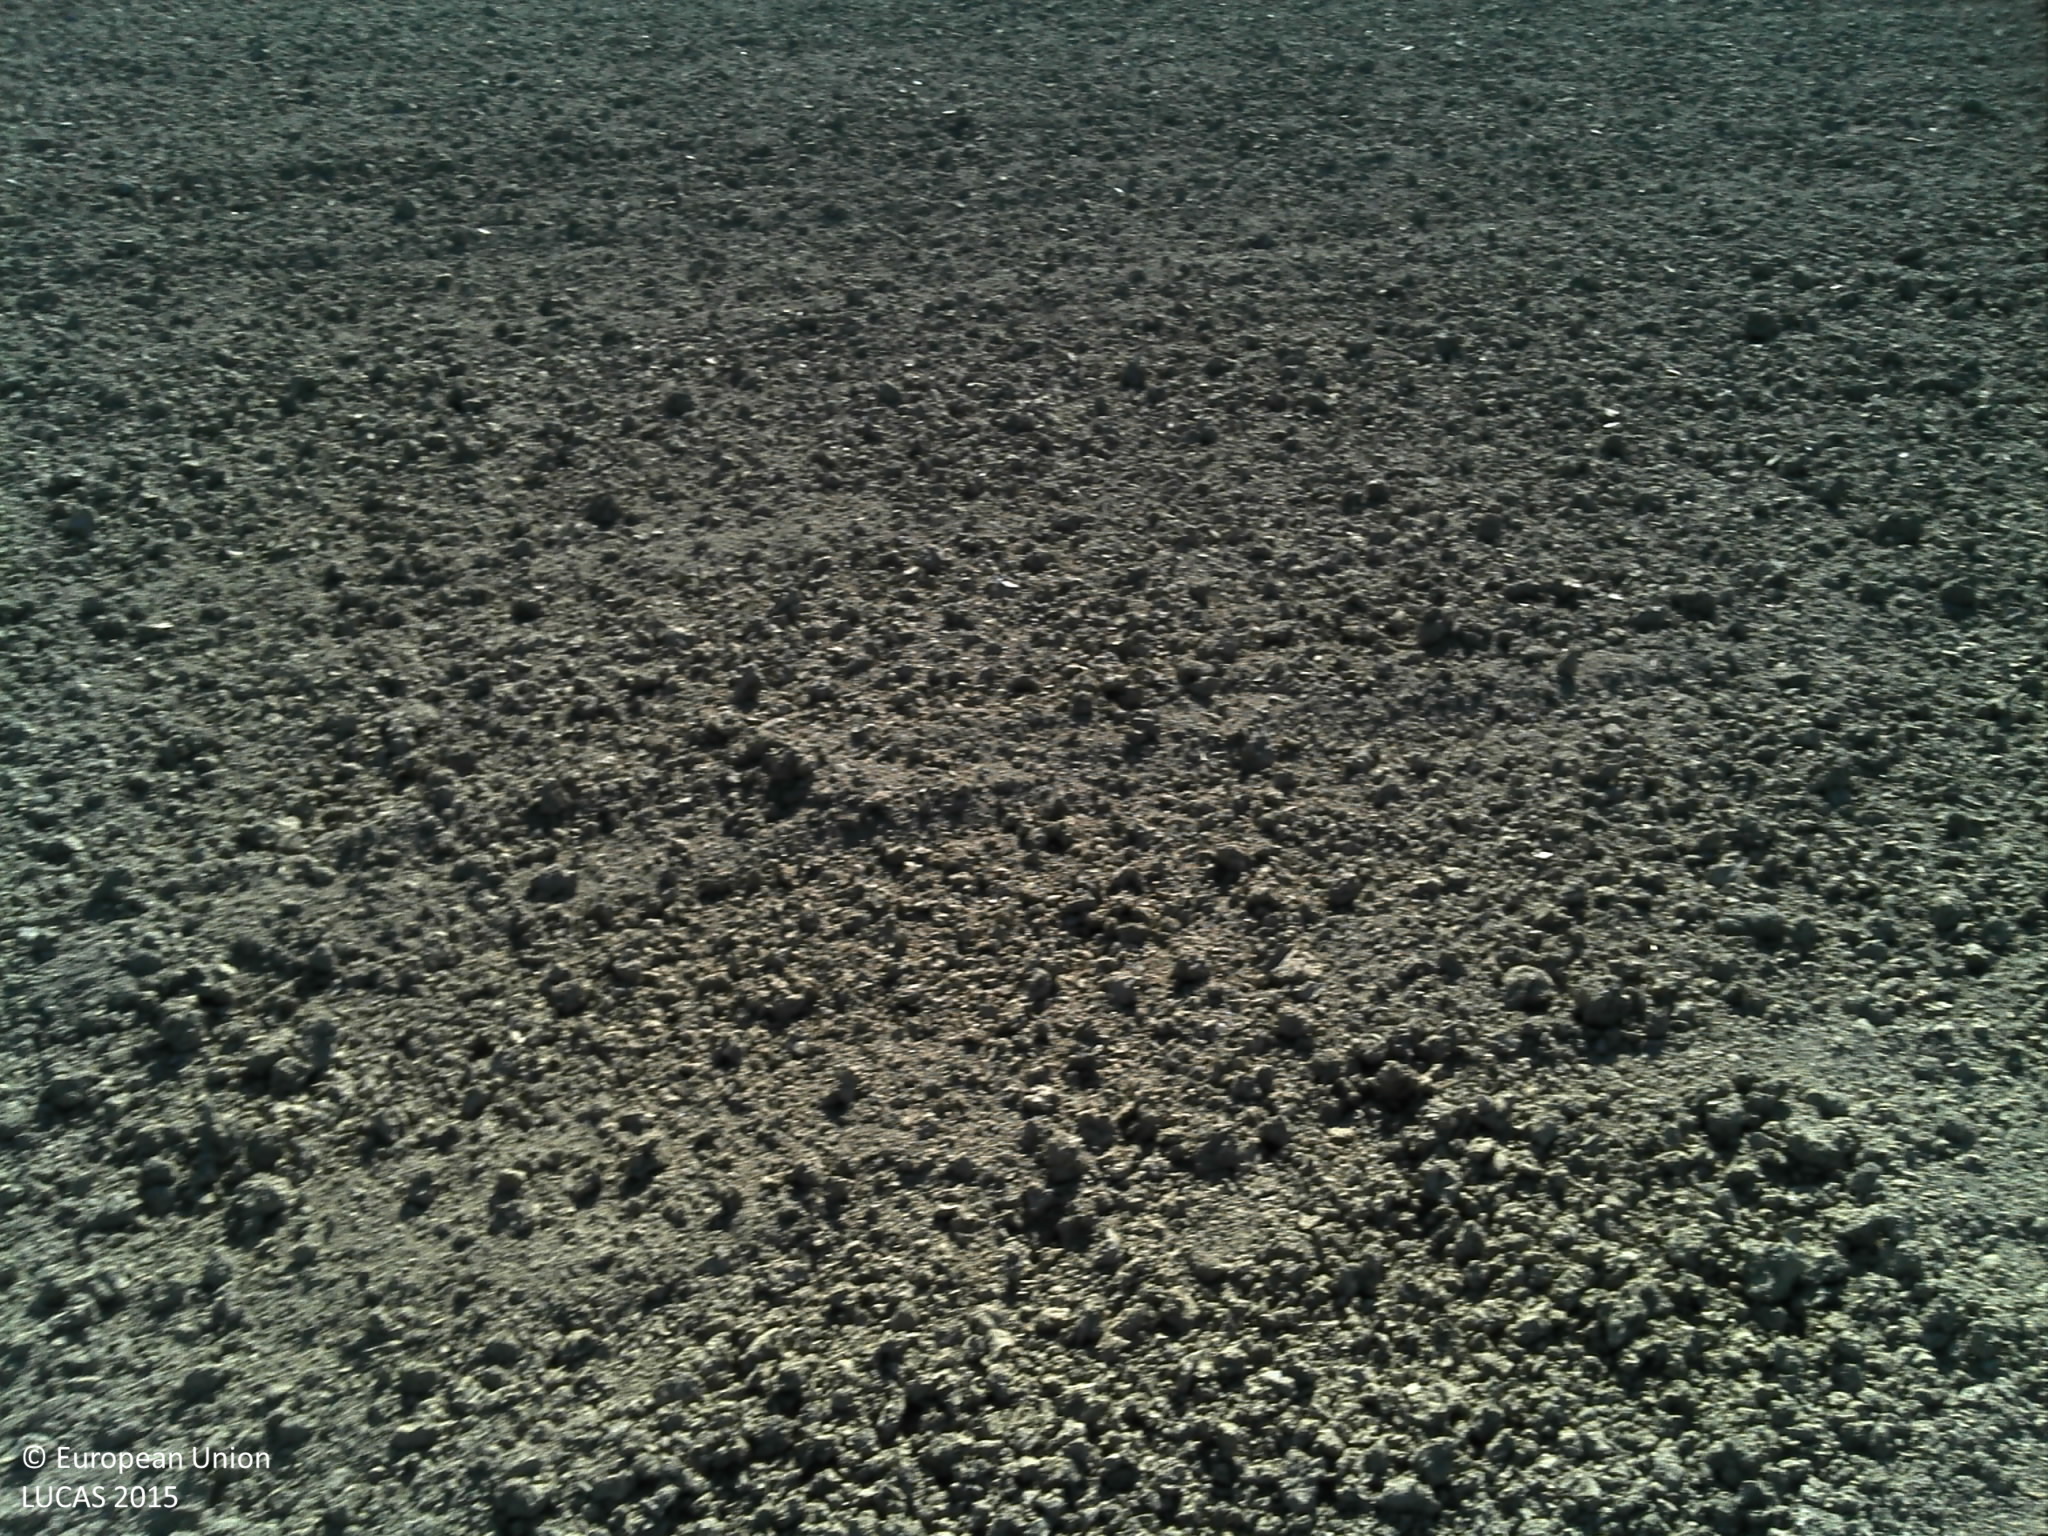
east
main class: Cropland
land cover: Soya
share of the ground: < 10 %
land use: Agriculture (excluding fallow land and kitchen gardens)
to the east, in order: Soya; Common wheat
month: April
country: HR
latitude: 45.2253
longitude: 18.6025
